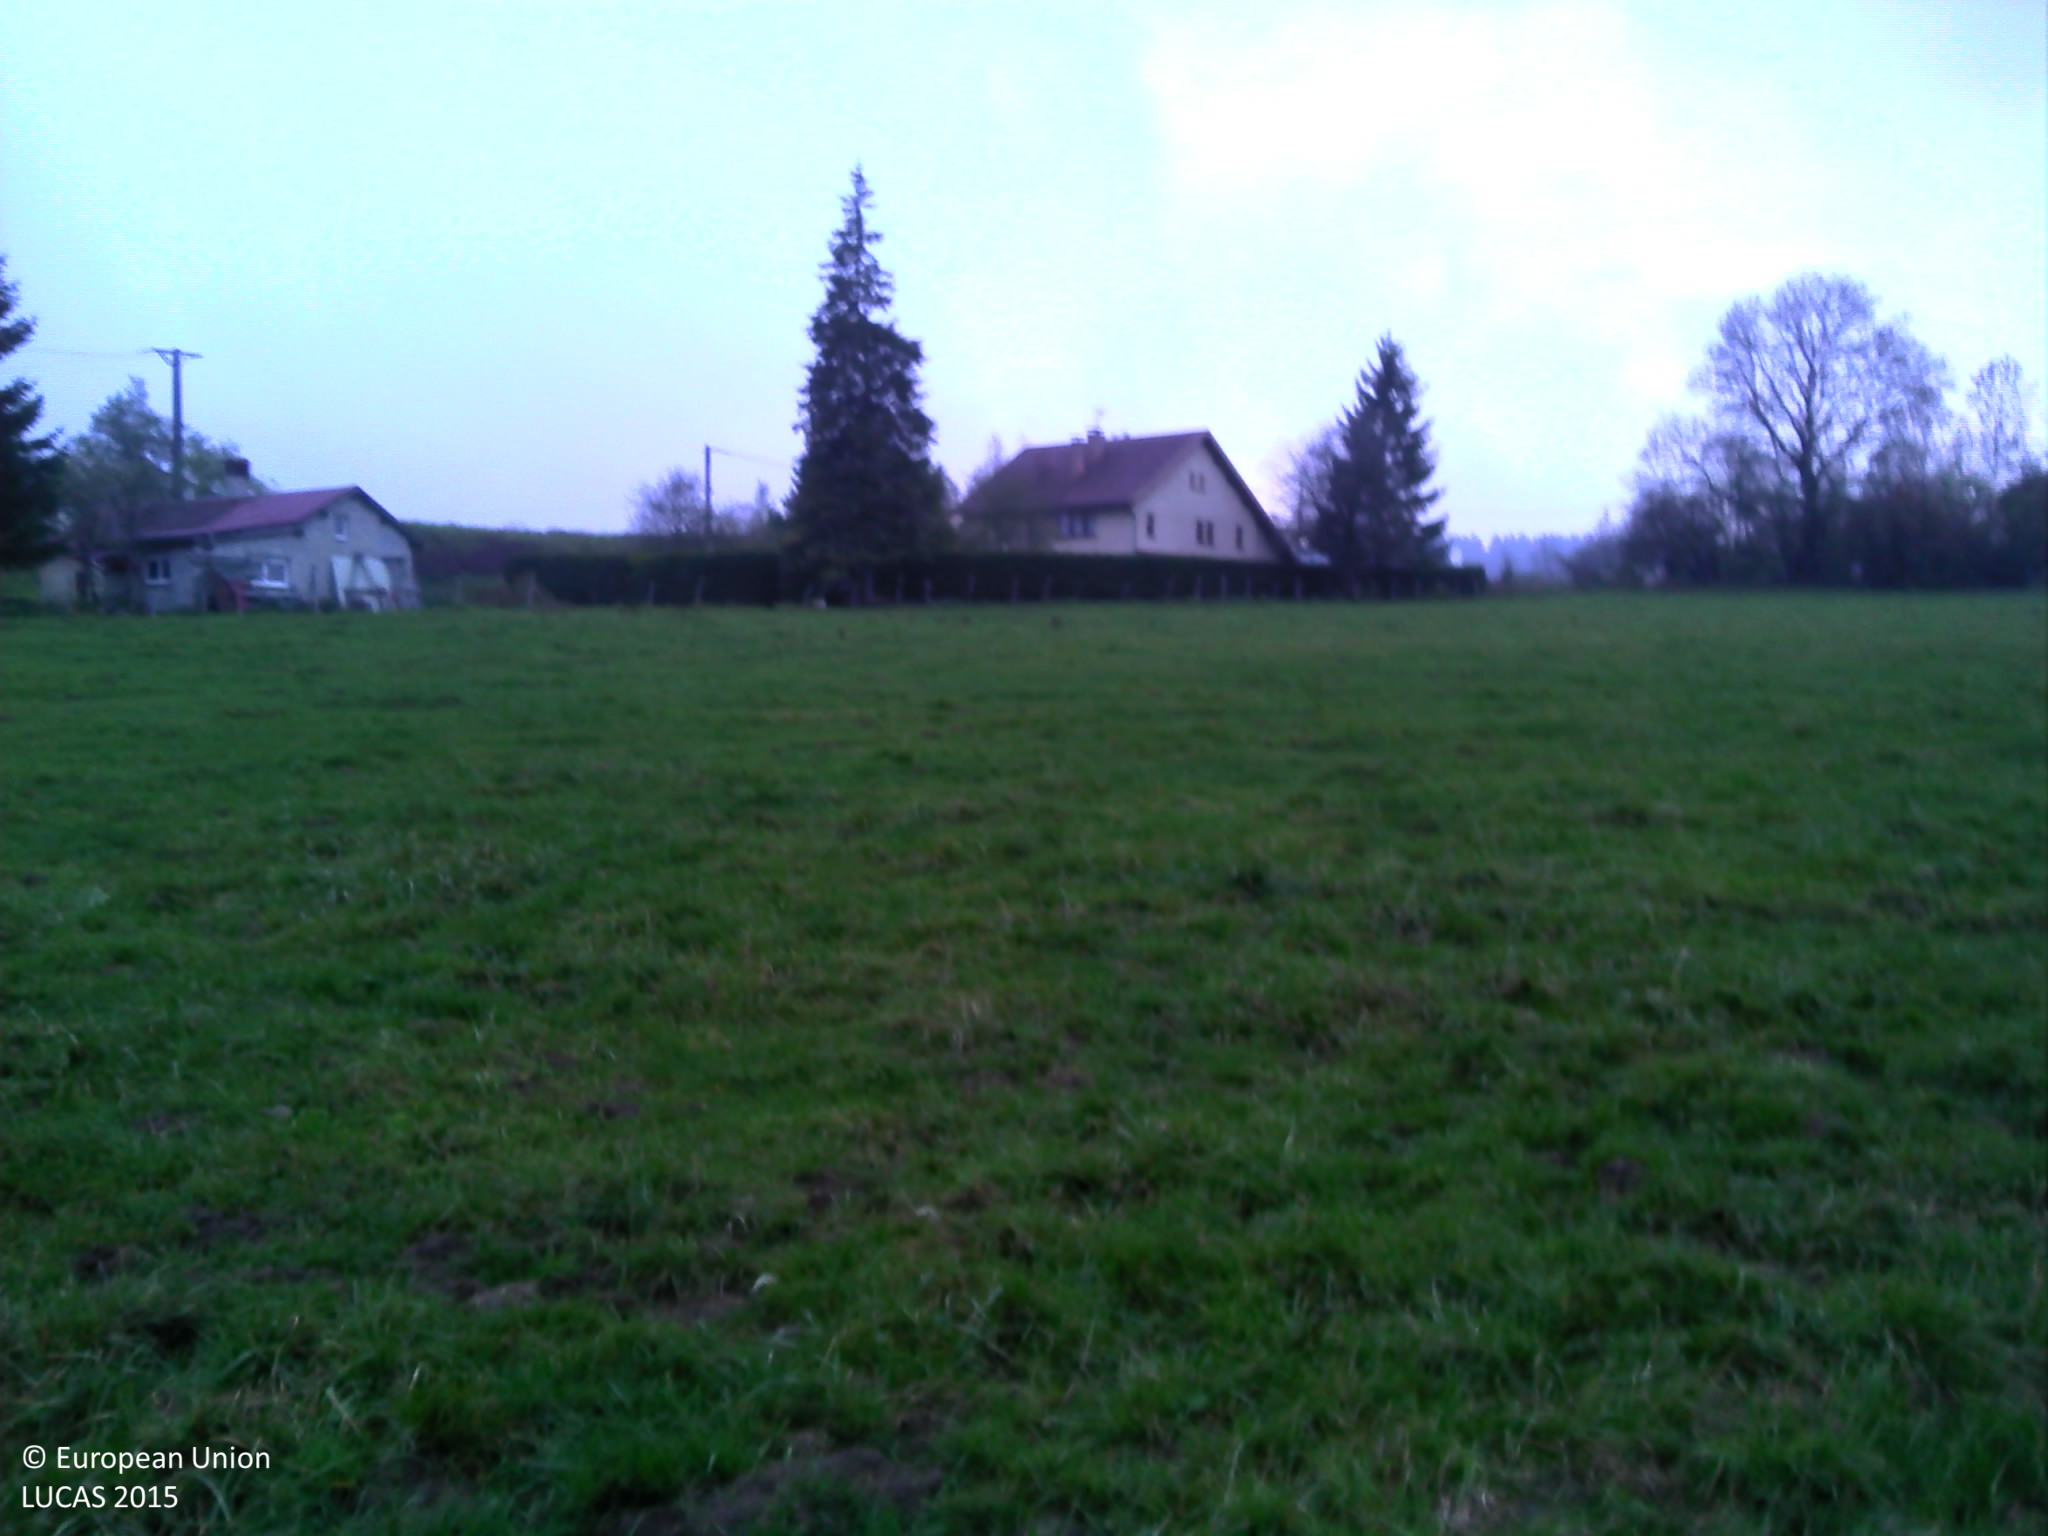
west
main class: Grassland
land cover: Grassland without tree/shrub cover
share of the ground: > 75 %
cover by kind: herbaceous plants 100 %
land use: Agriculture (excluding fallow land and kitchen gardens)
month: October
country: FR
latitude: 46.8923
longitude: 6.0780
